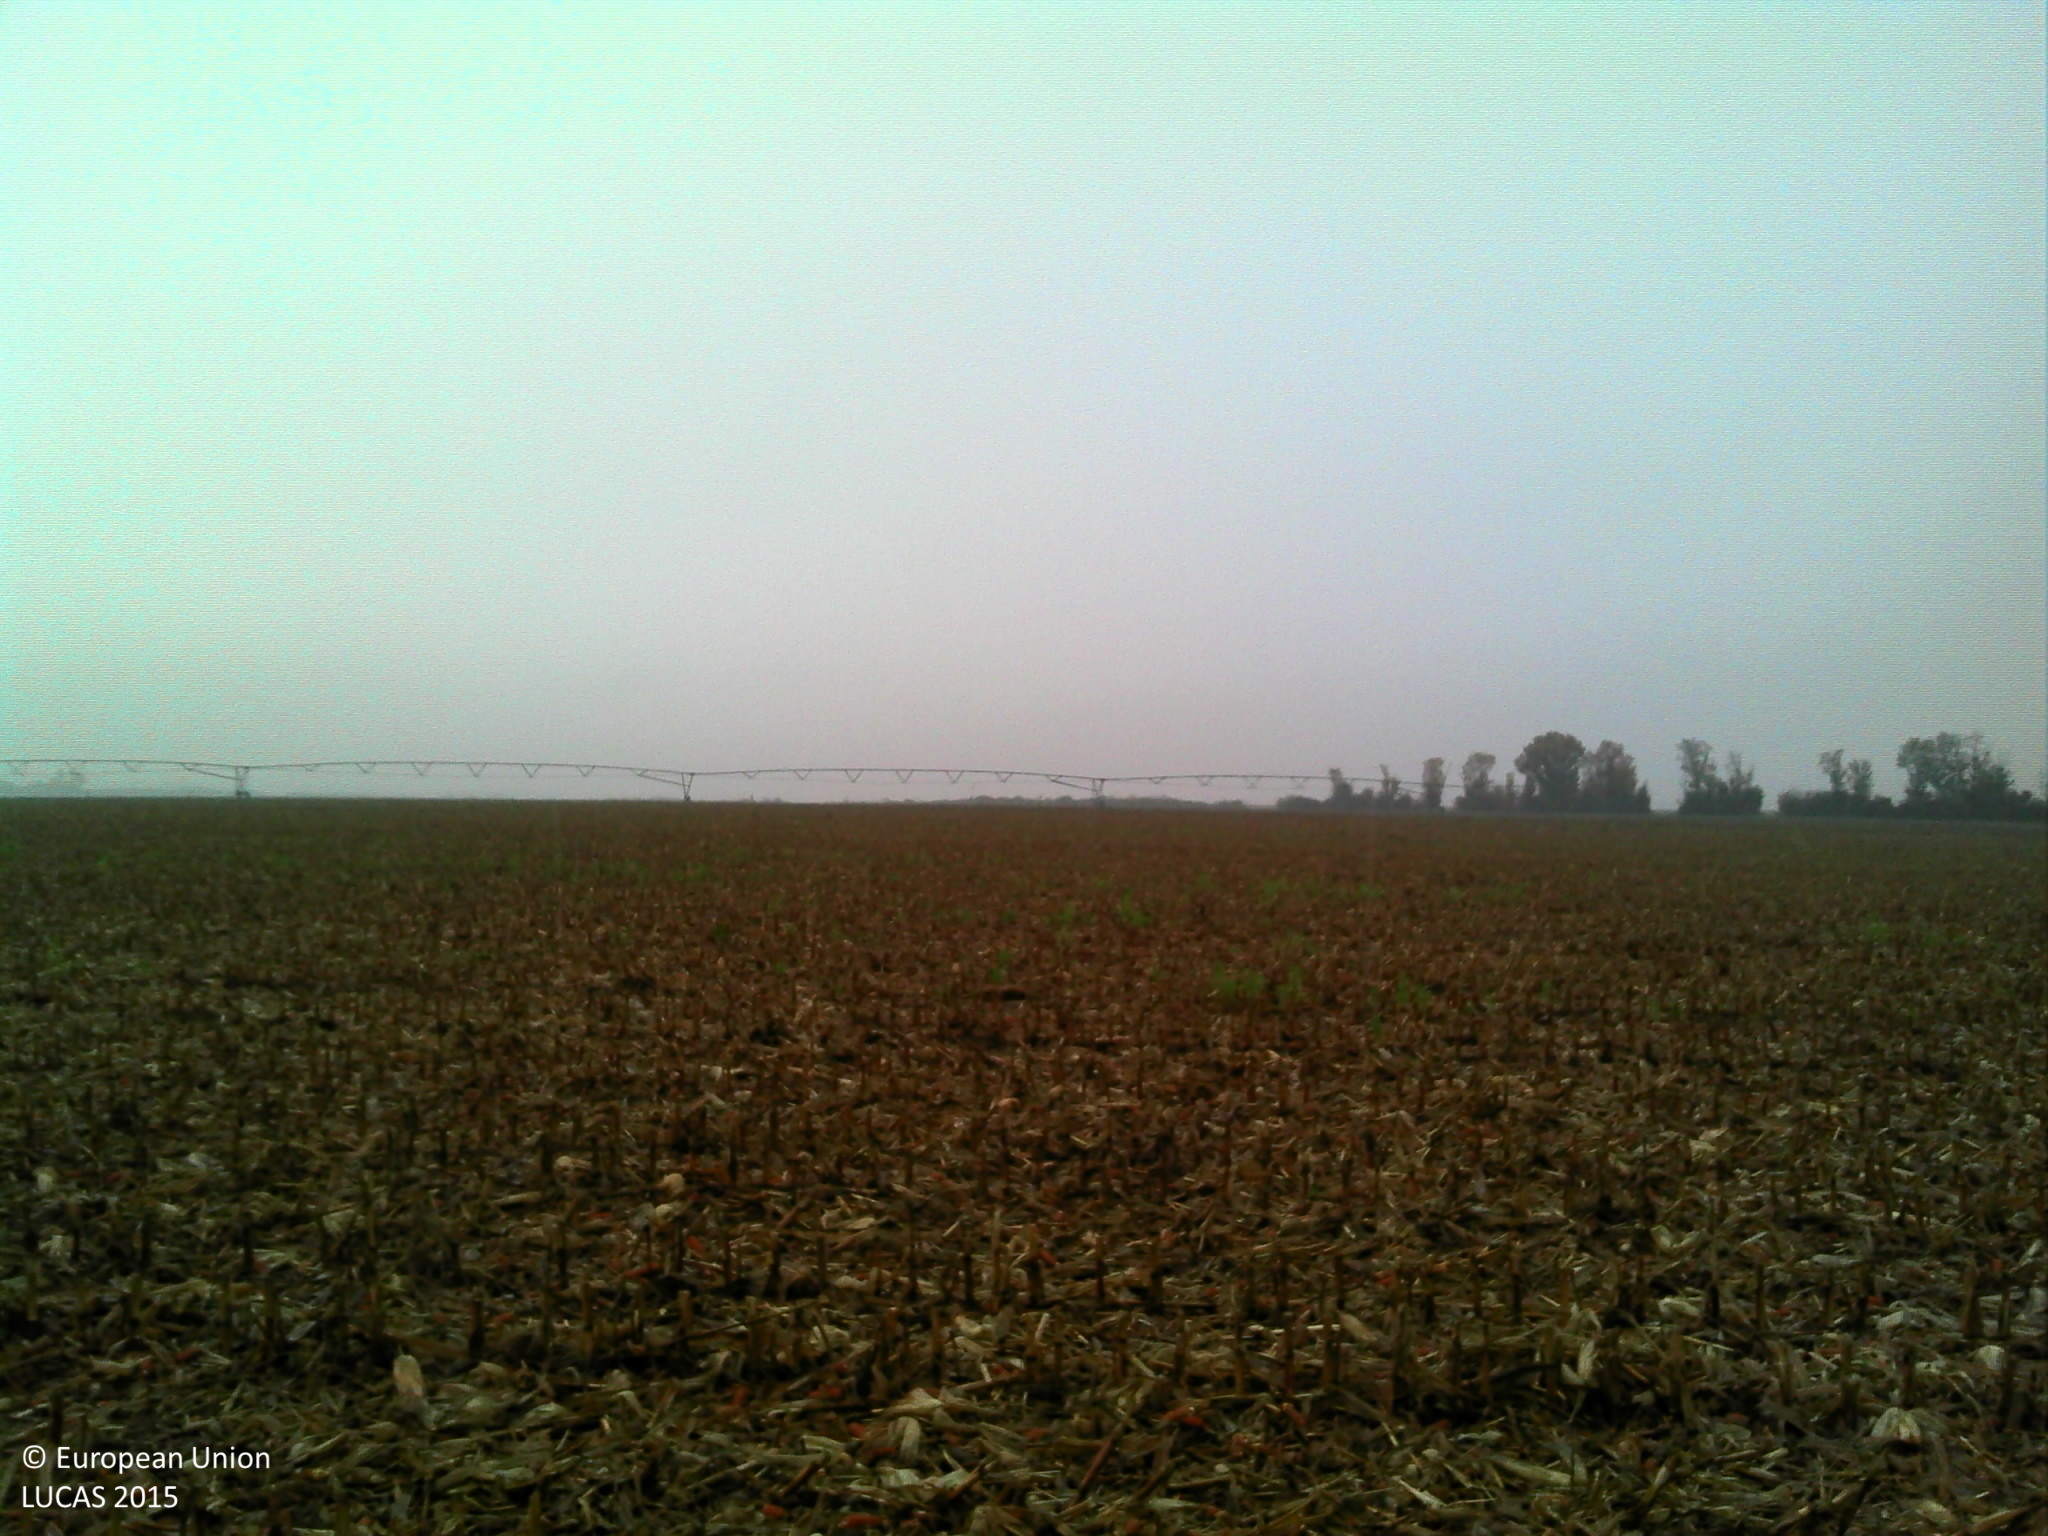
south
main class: Cropland
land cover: Maize
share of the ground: 10 - 25 %
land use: Agriculture (excluding fallow land and kitchen gardens)
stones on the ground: 10 - 25 %
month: December
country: FR
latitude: 45.8813
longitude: 5.1718
